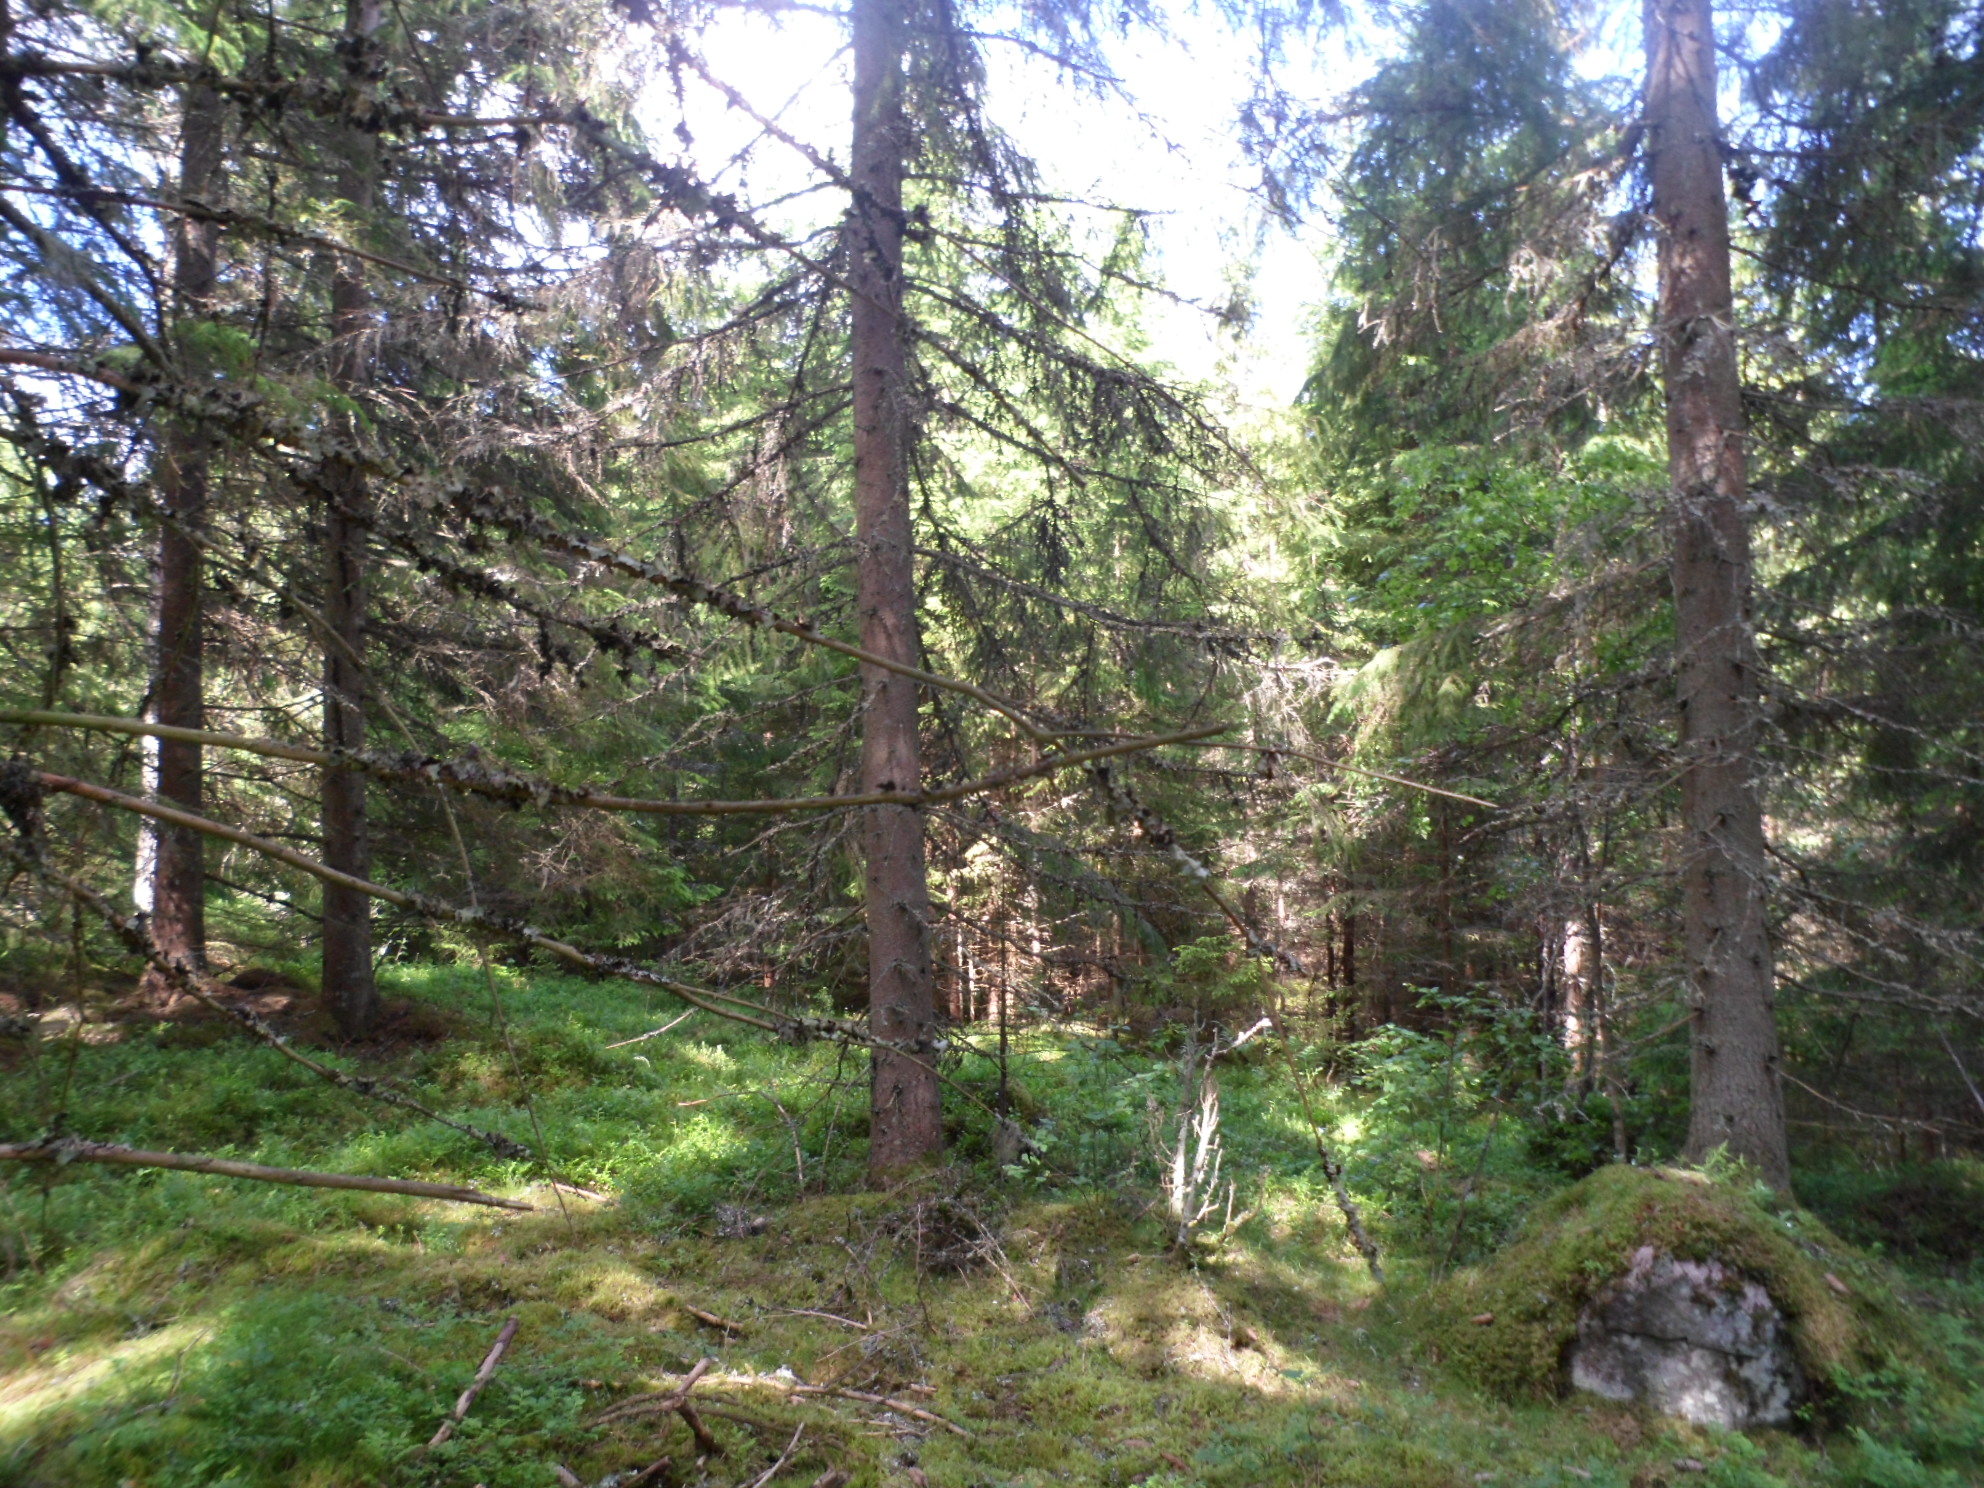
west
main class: Woodland
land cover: Spruce dominated coniferous woodland
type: boreal forest
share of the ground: 50 - 75 %
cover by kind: coniferous forest trees 60 %, lichens and mosses 20 %, shrubs 15 %, herbaceous plants 5 %
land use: Forestry
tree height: > 5 m
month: June
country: SE
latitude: 57.1414
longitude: 14.8386
